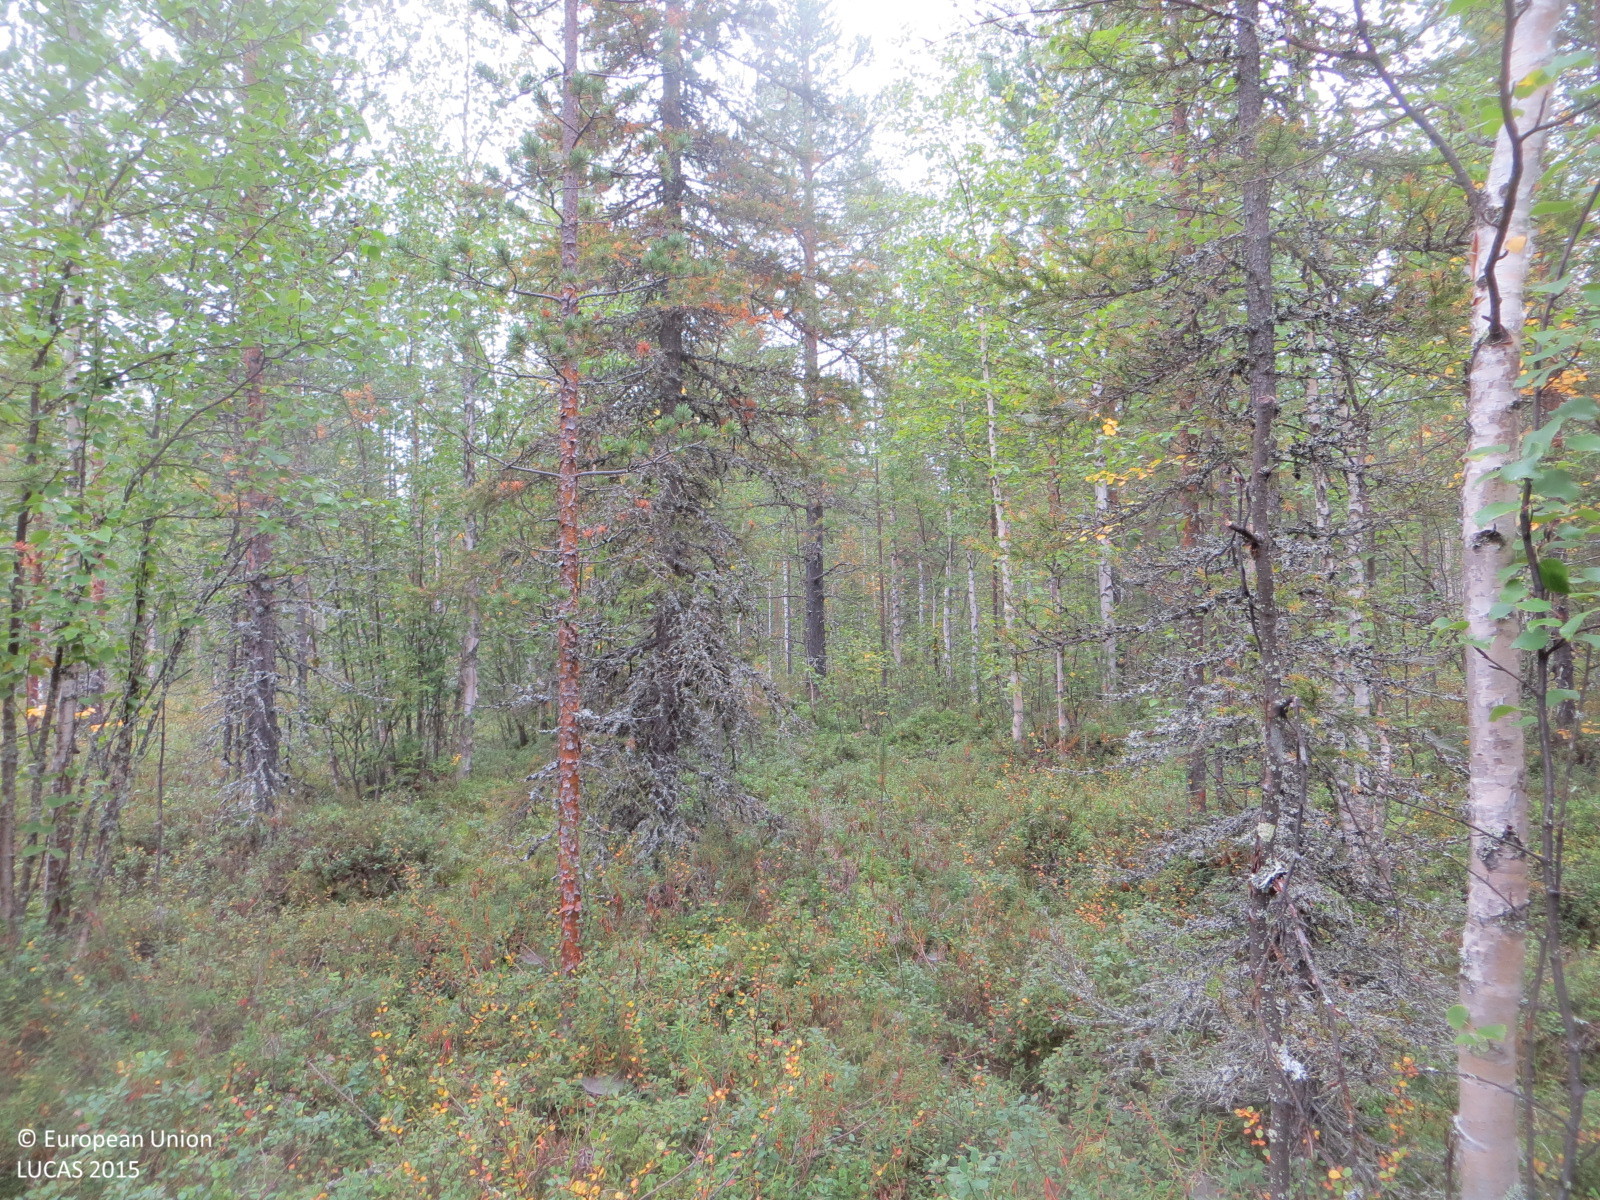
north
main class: Woodland
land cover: Pine dominated mixed woodland
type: mire and swamp forests
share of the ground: 50 - 75 %
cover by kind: coniferous forest trees 45 %, shrubs 30 %, broadleaved forest trees 25 %
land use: Forestry
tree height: > 5 m
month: August
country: FI
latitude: 67.3572
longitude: 23.9198
